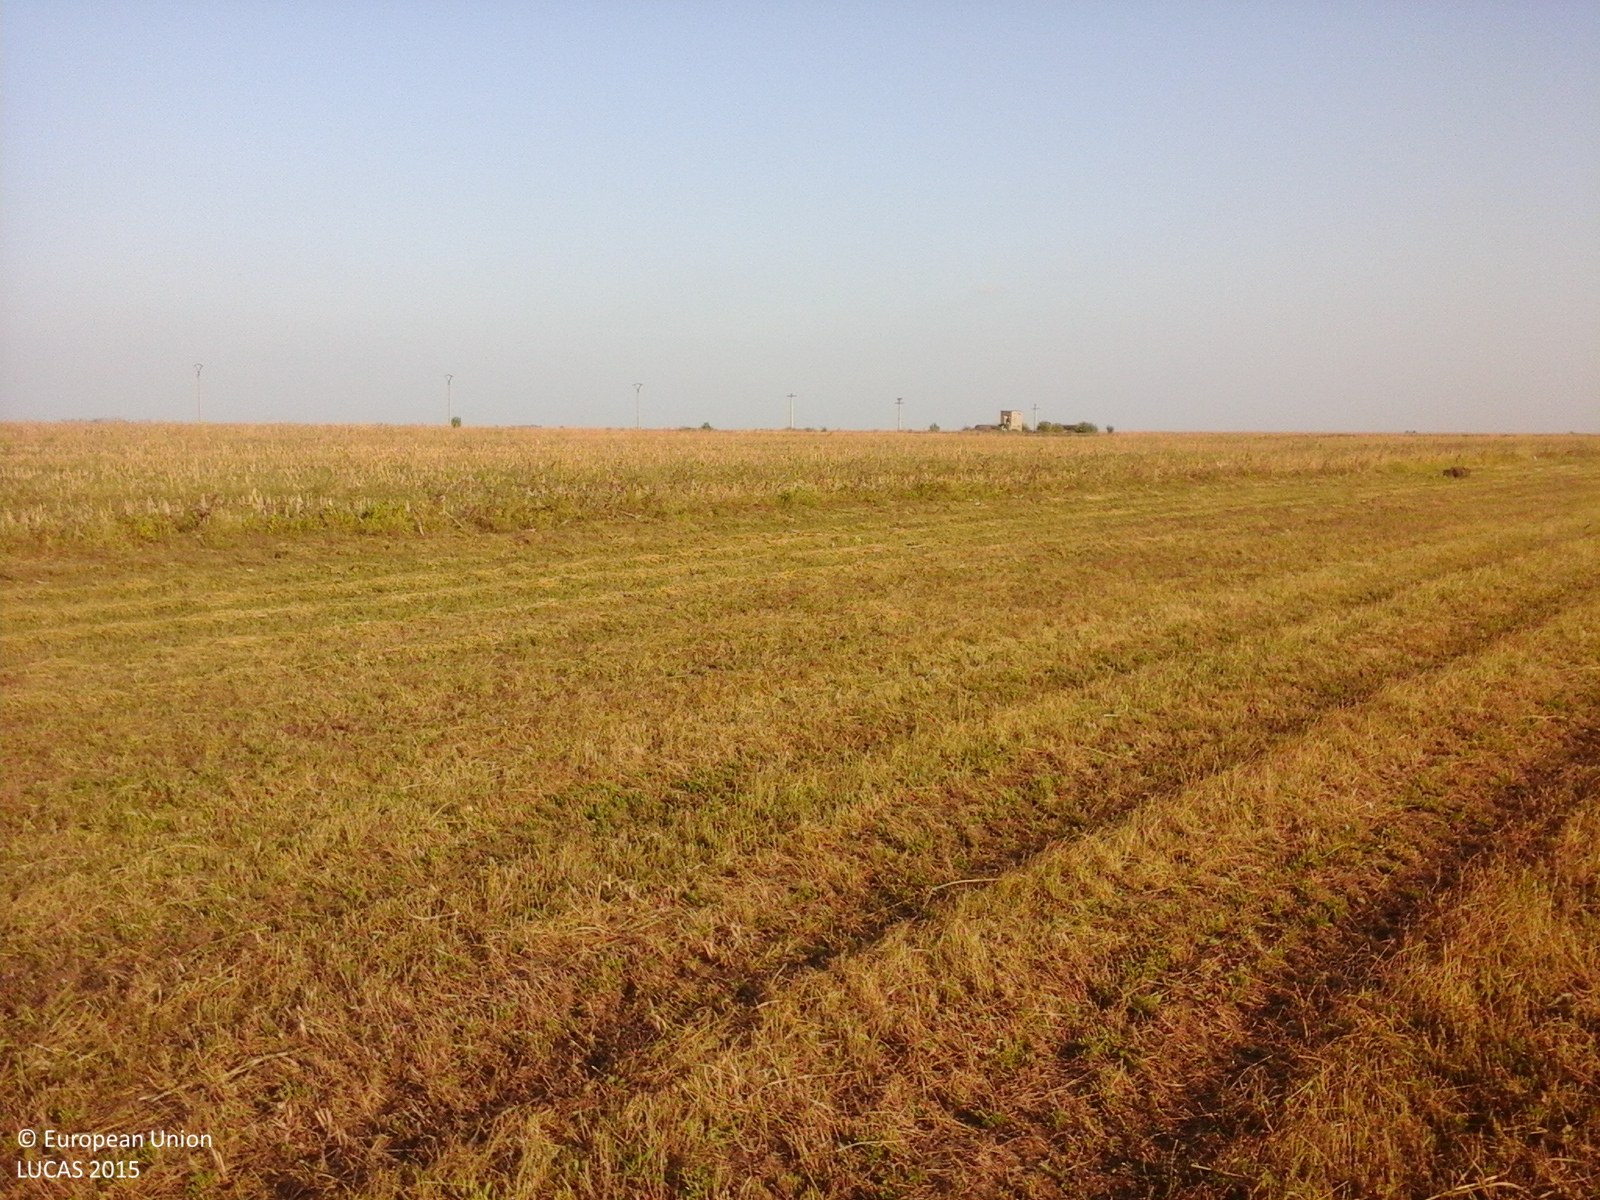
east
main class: Cropland
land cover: Lucerne
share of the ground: > 75 %
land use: Agriculture (excluding fallow land and kitchen gardens)
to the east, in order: Lucerne; Grass margins; Maize; Grass margins; Sunflower
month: October
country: RO
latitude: 45.1924
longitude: 26.9229
